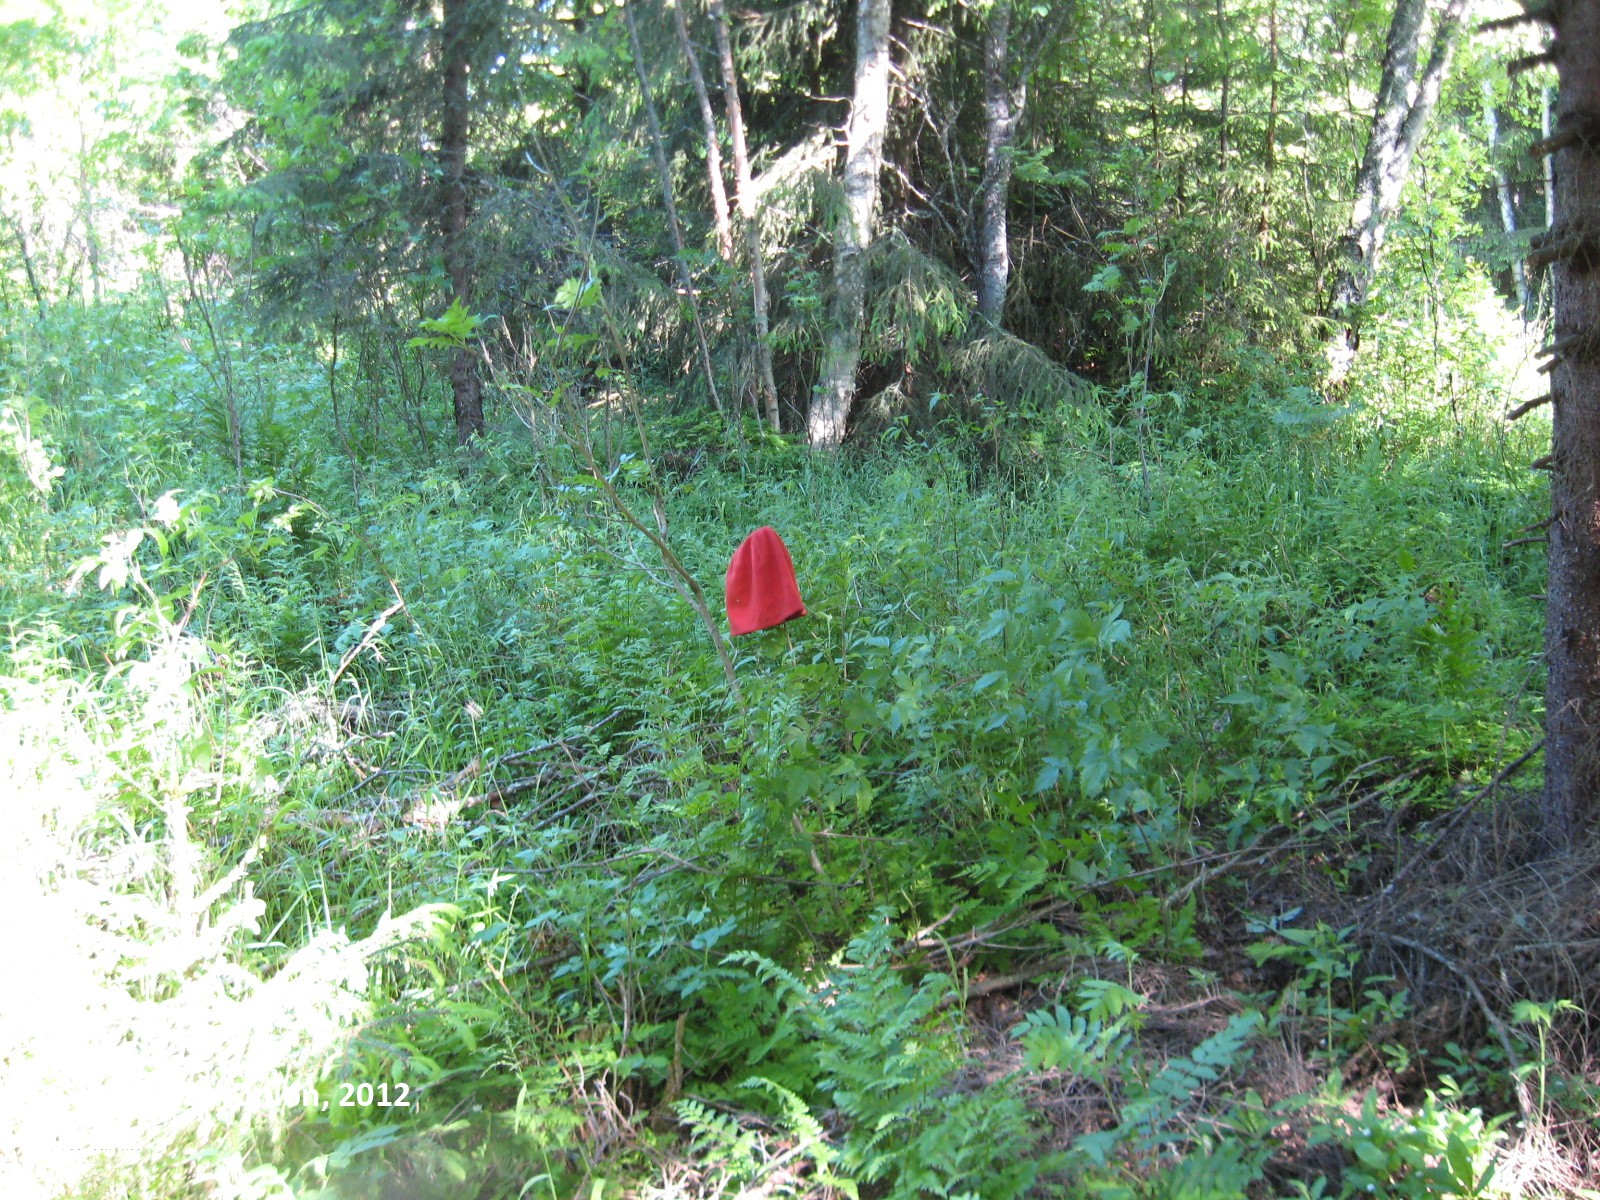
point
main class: Woodland
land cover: Other mixed woodland
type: boreal forest
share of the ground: > 75 %
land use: Forestry
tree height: > 5 m
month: June
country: FI
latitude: 62.9676
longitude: 21.8172
